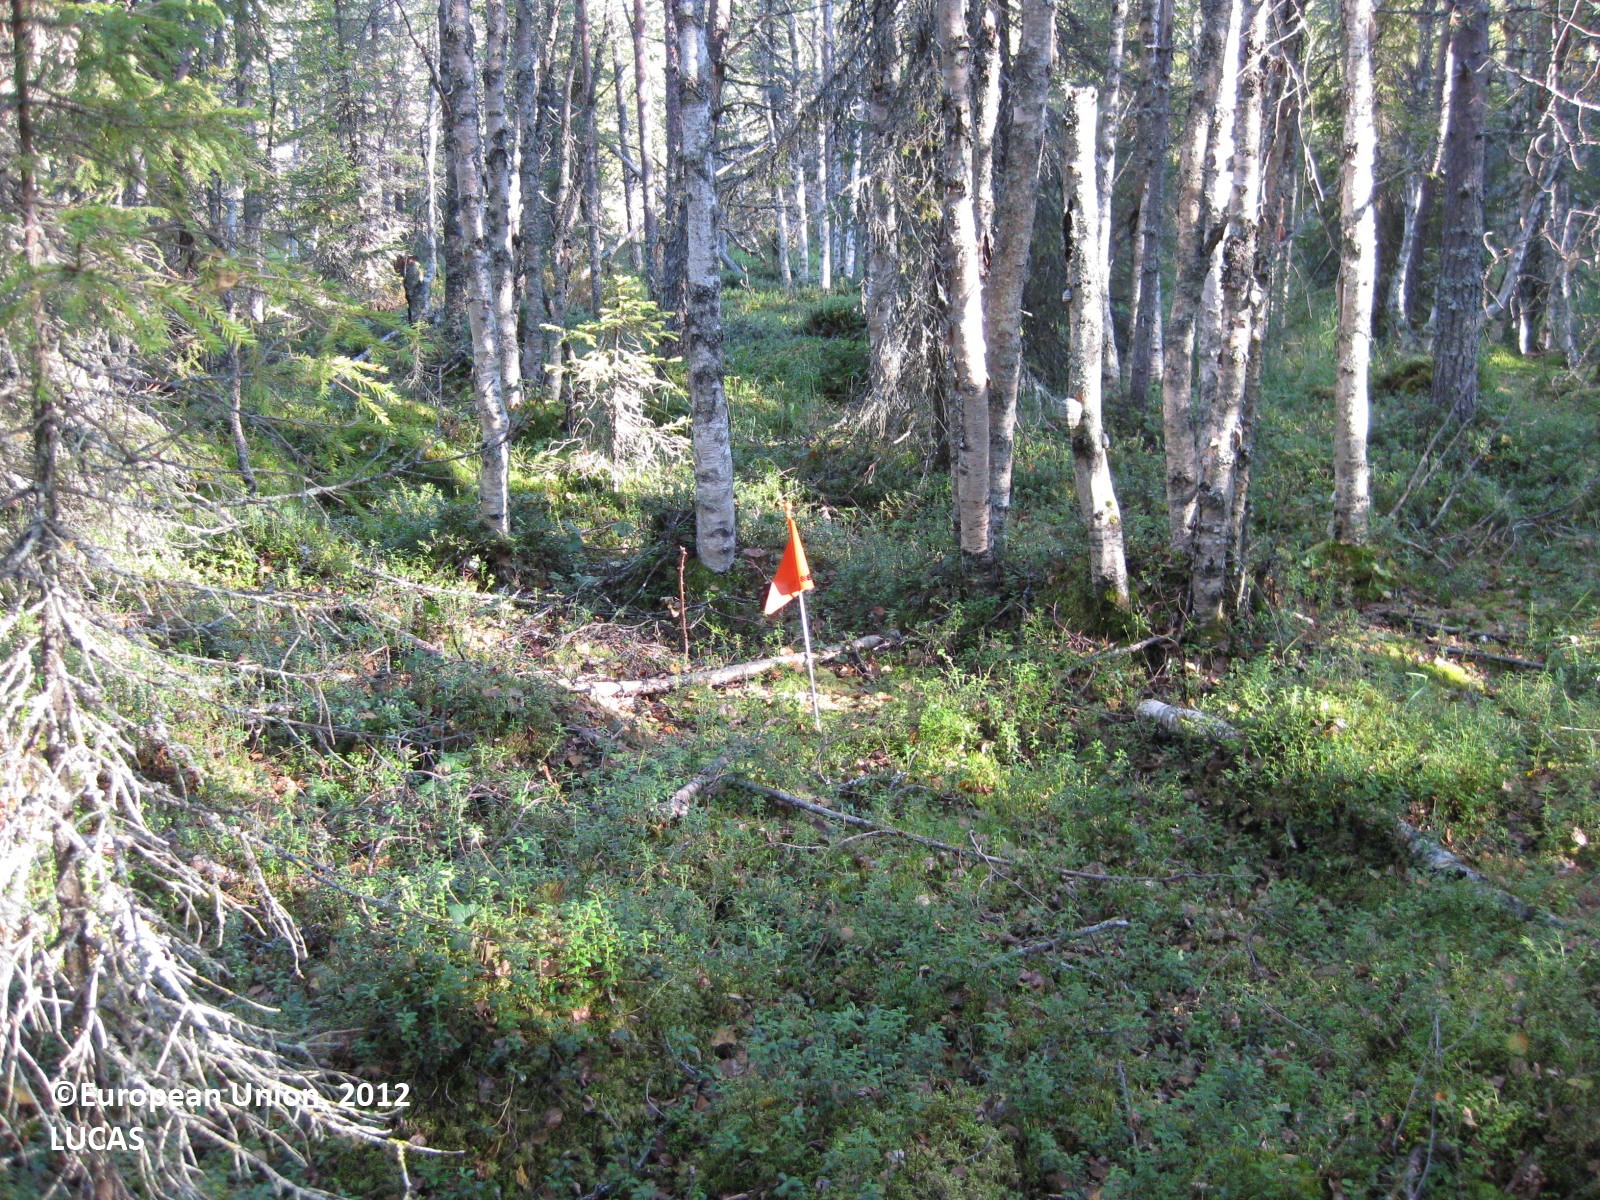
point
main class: Woodland
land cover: Other mixed woodland
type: boreal forest
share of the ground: > 75 %
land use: Forestry
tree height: > 5 m
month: August
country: FI
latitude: 66.0520
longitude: 29.5542
